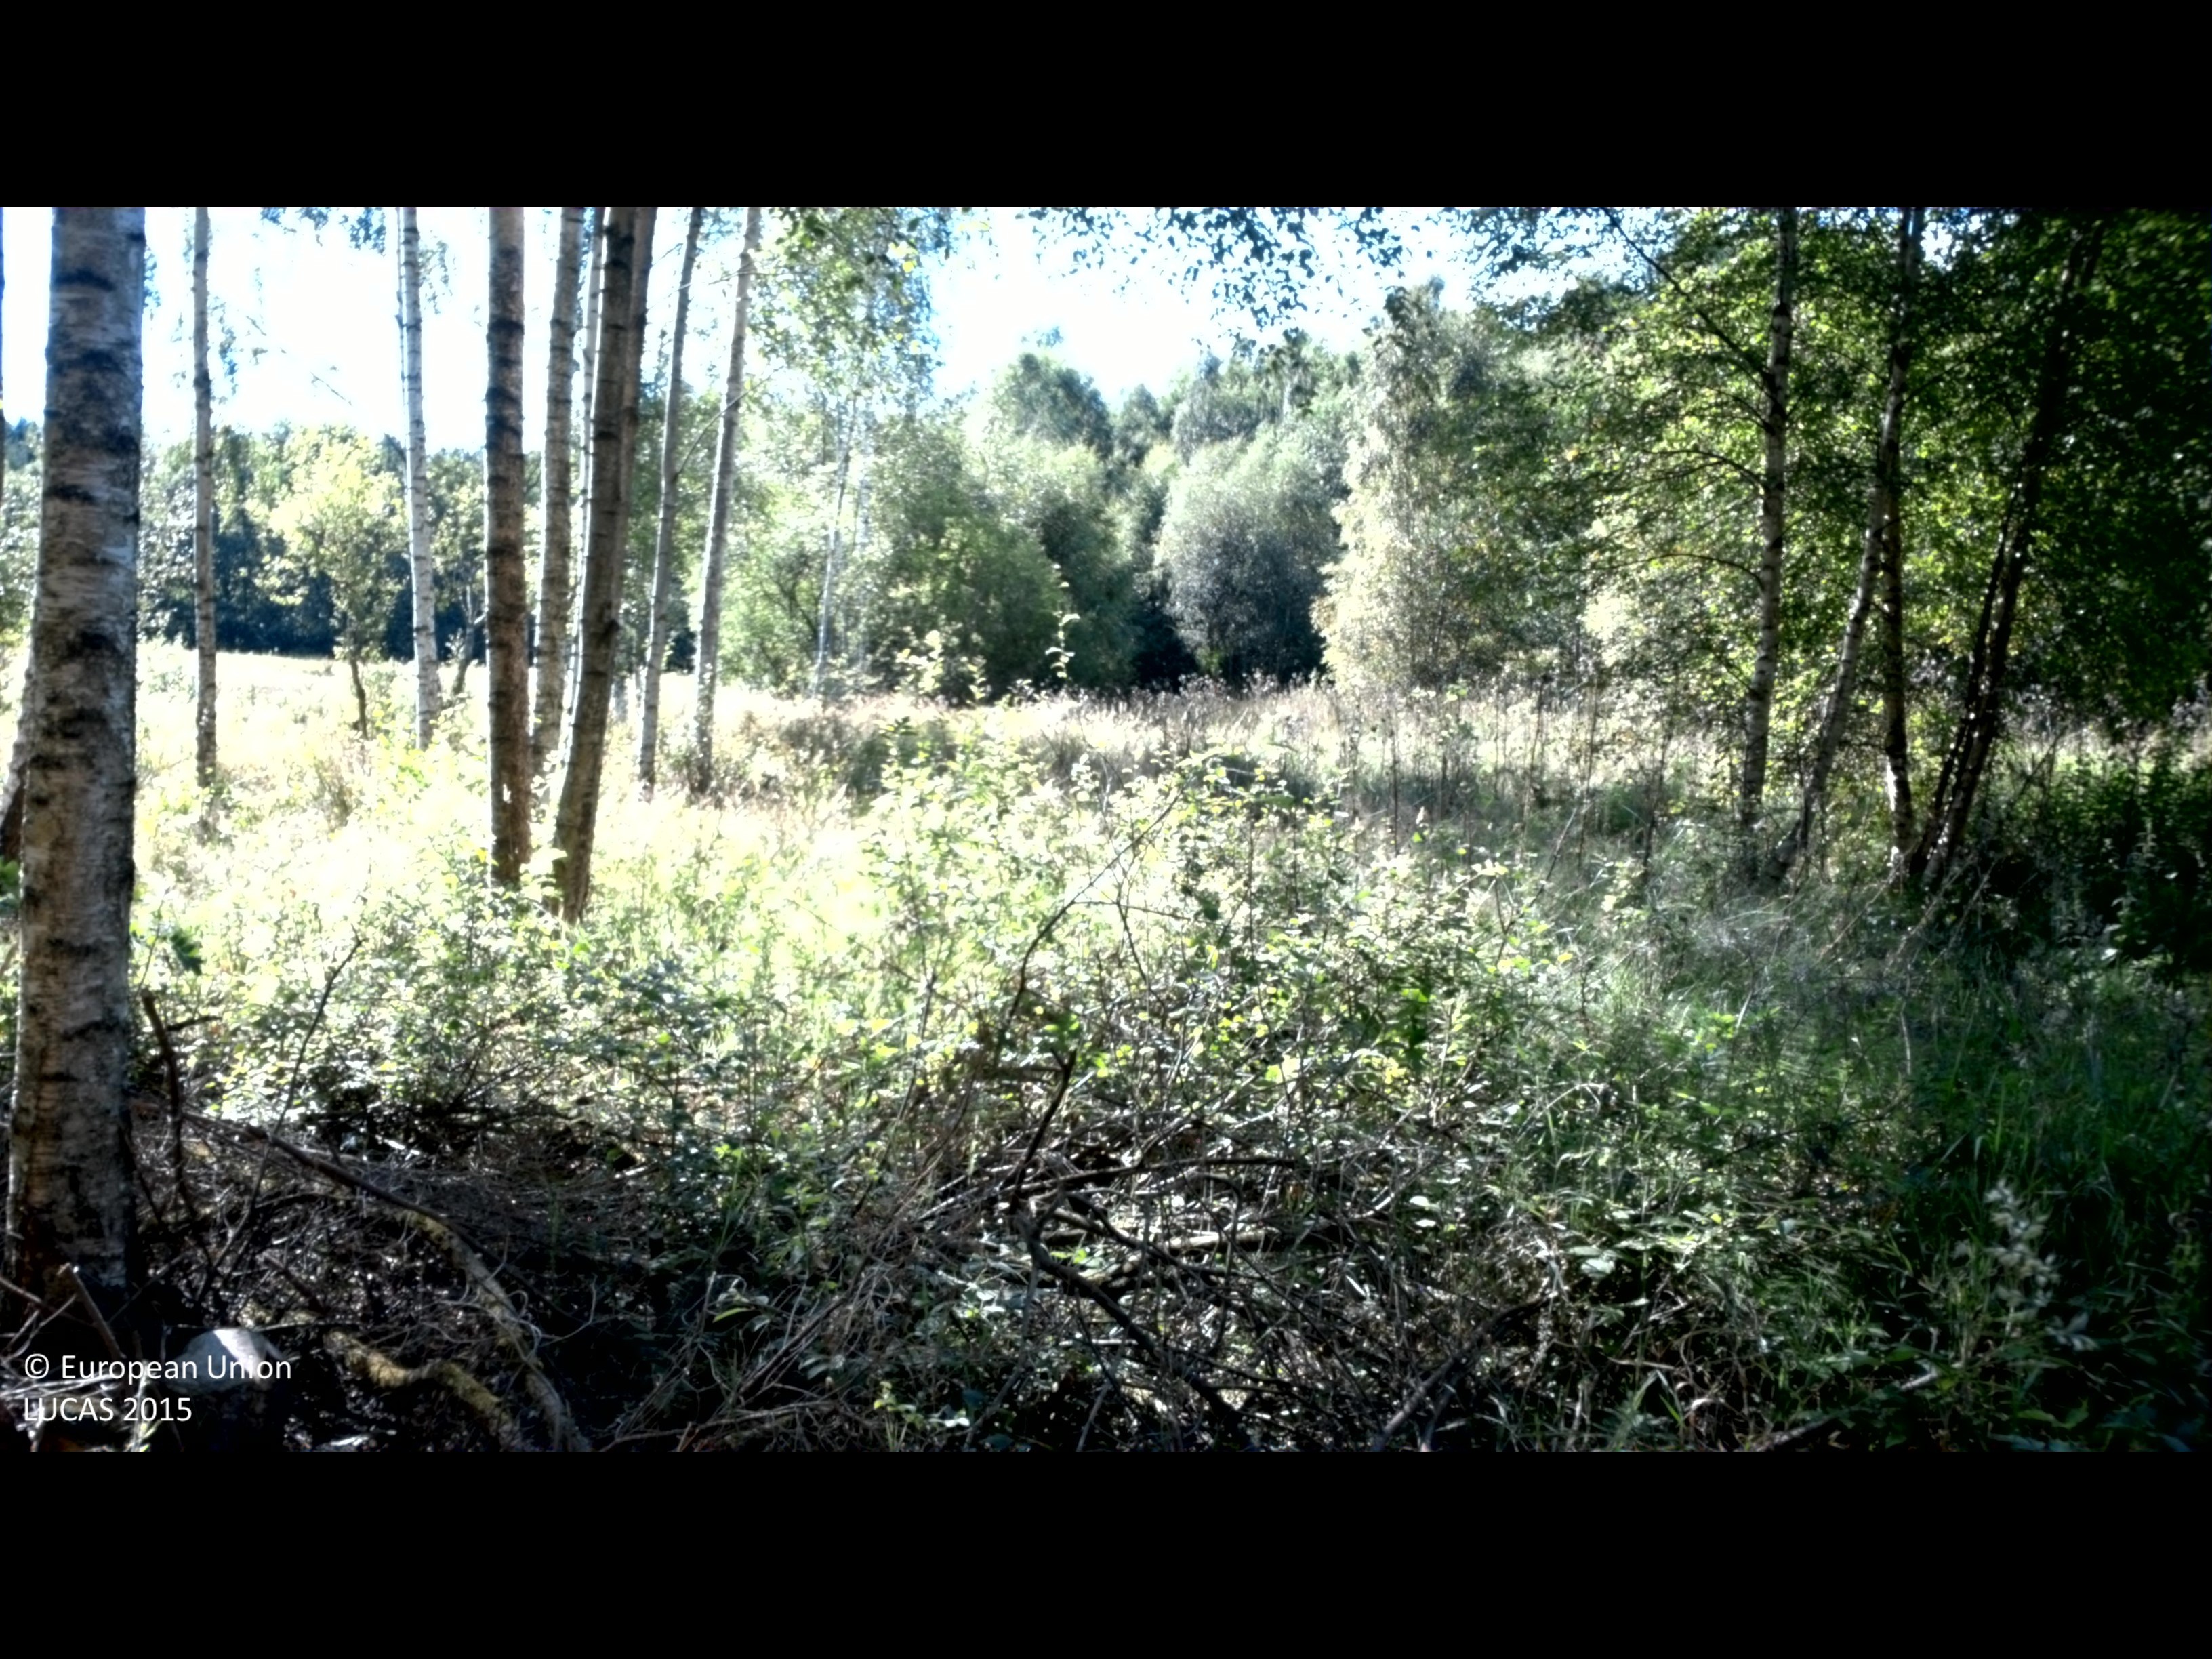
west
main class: Woodland
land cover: Broadleaved woodland
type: hemiboreal forest and nemoral coniferous forest and mixed broadleaved-coniferous forest
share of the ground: 25 - 50 %
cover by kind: herbaceous plants 55 %, broadleaved forest trees 35 %, shrubs 10 %
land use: Forestry
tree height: > 5 m
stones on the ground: < 10 %
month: August
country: SE
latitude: 56.3369
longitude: 14.6728
